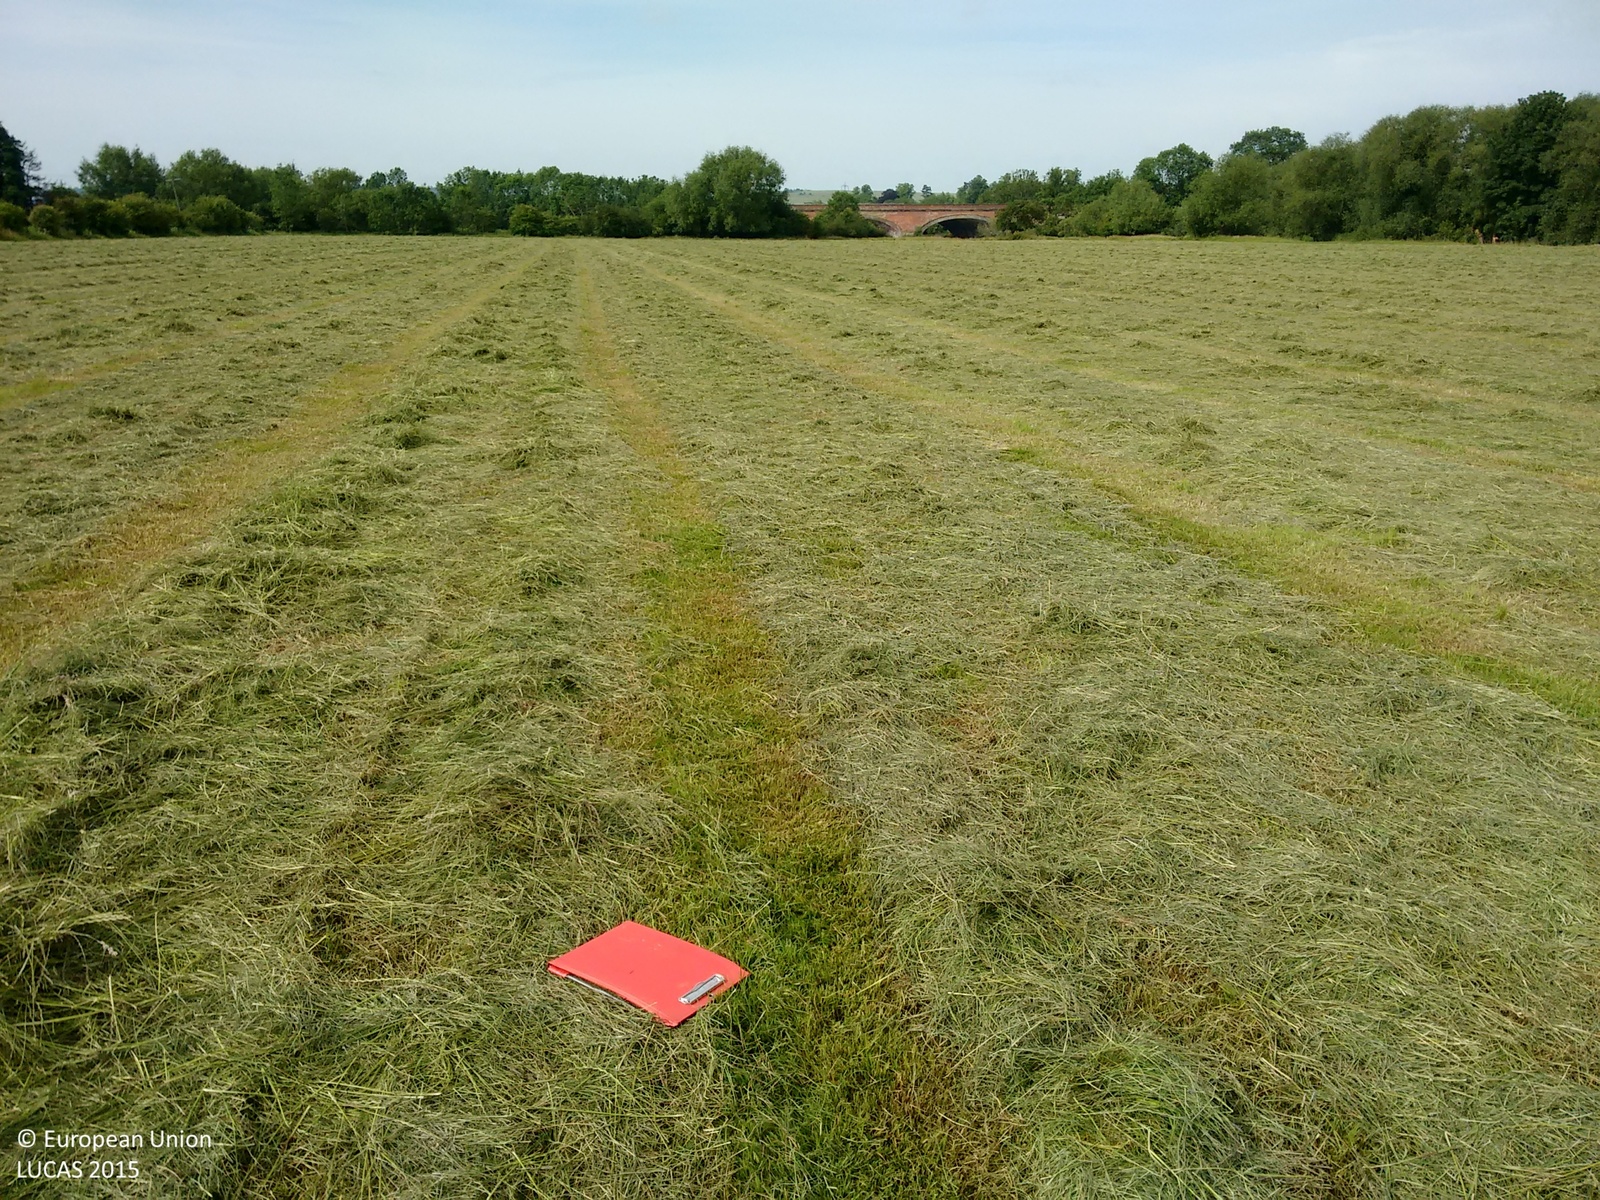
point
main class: Grassland
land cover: Grassland without tree/shrub cover
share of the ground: > 75 %
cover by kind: herbaceous plants 100 %
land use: Agriculture (excluding fallow land and kitchen gardens)
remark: Harvested field
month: June
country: GB
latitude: 51.5609
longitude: -1.1389
